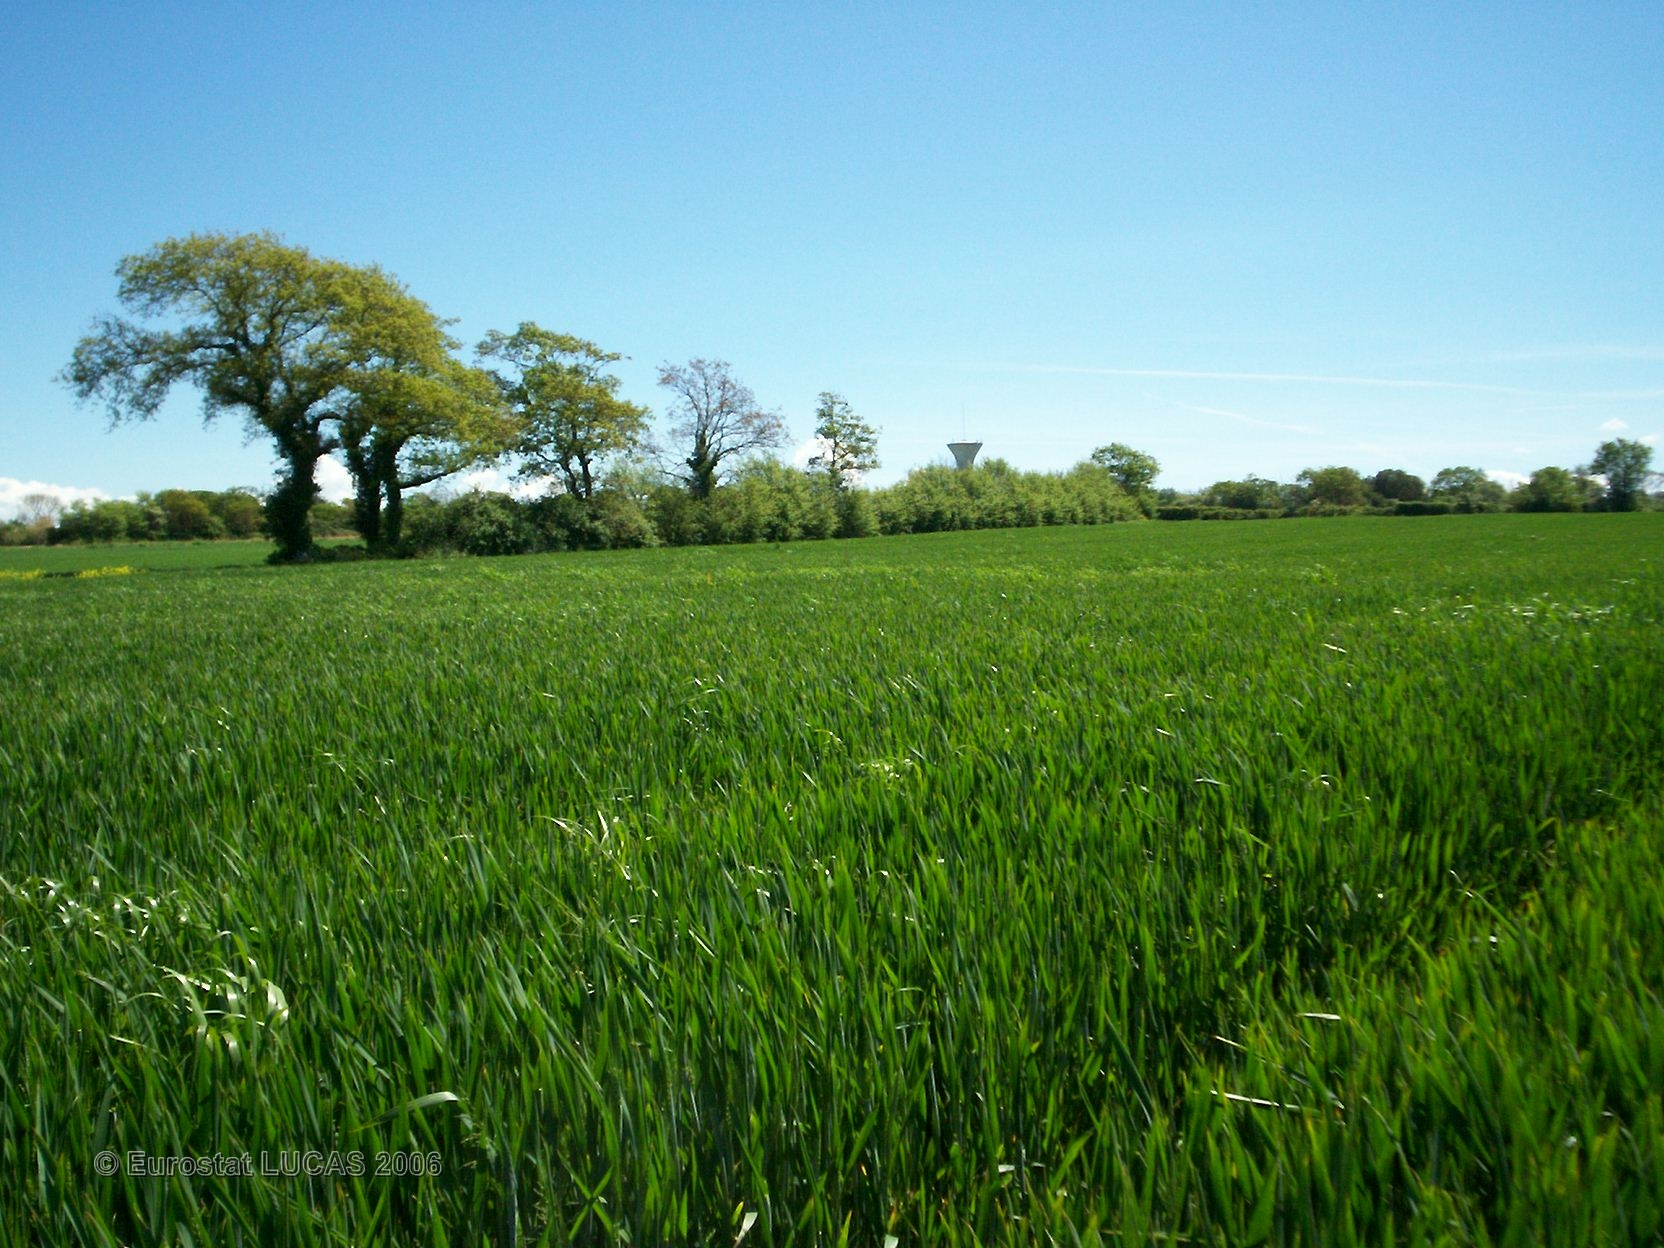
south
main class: Cropland
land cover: Triticale
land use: Agriculture (excluding fallow land and kitchen gardens)
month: May
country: FR
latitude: 47.1461
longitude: -2.1691
